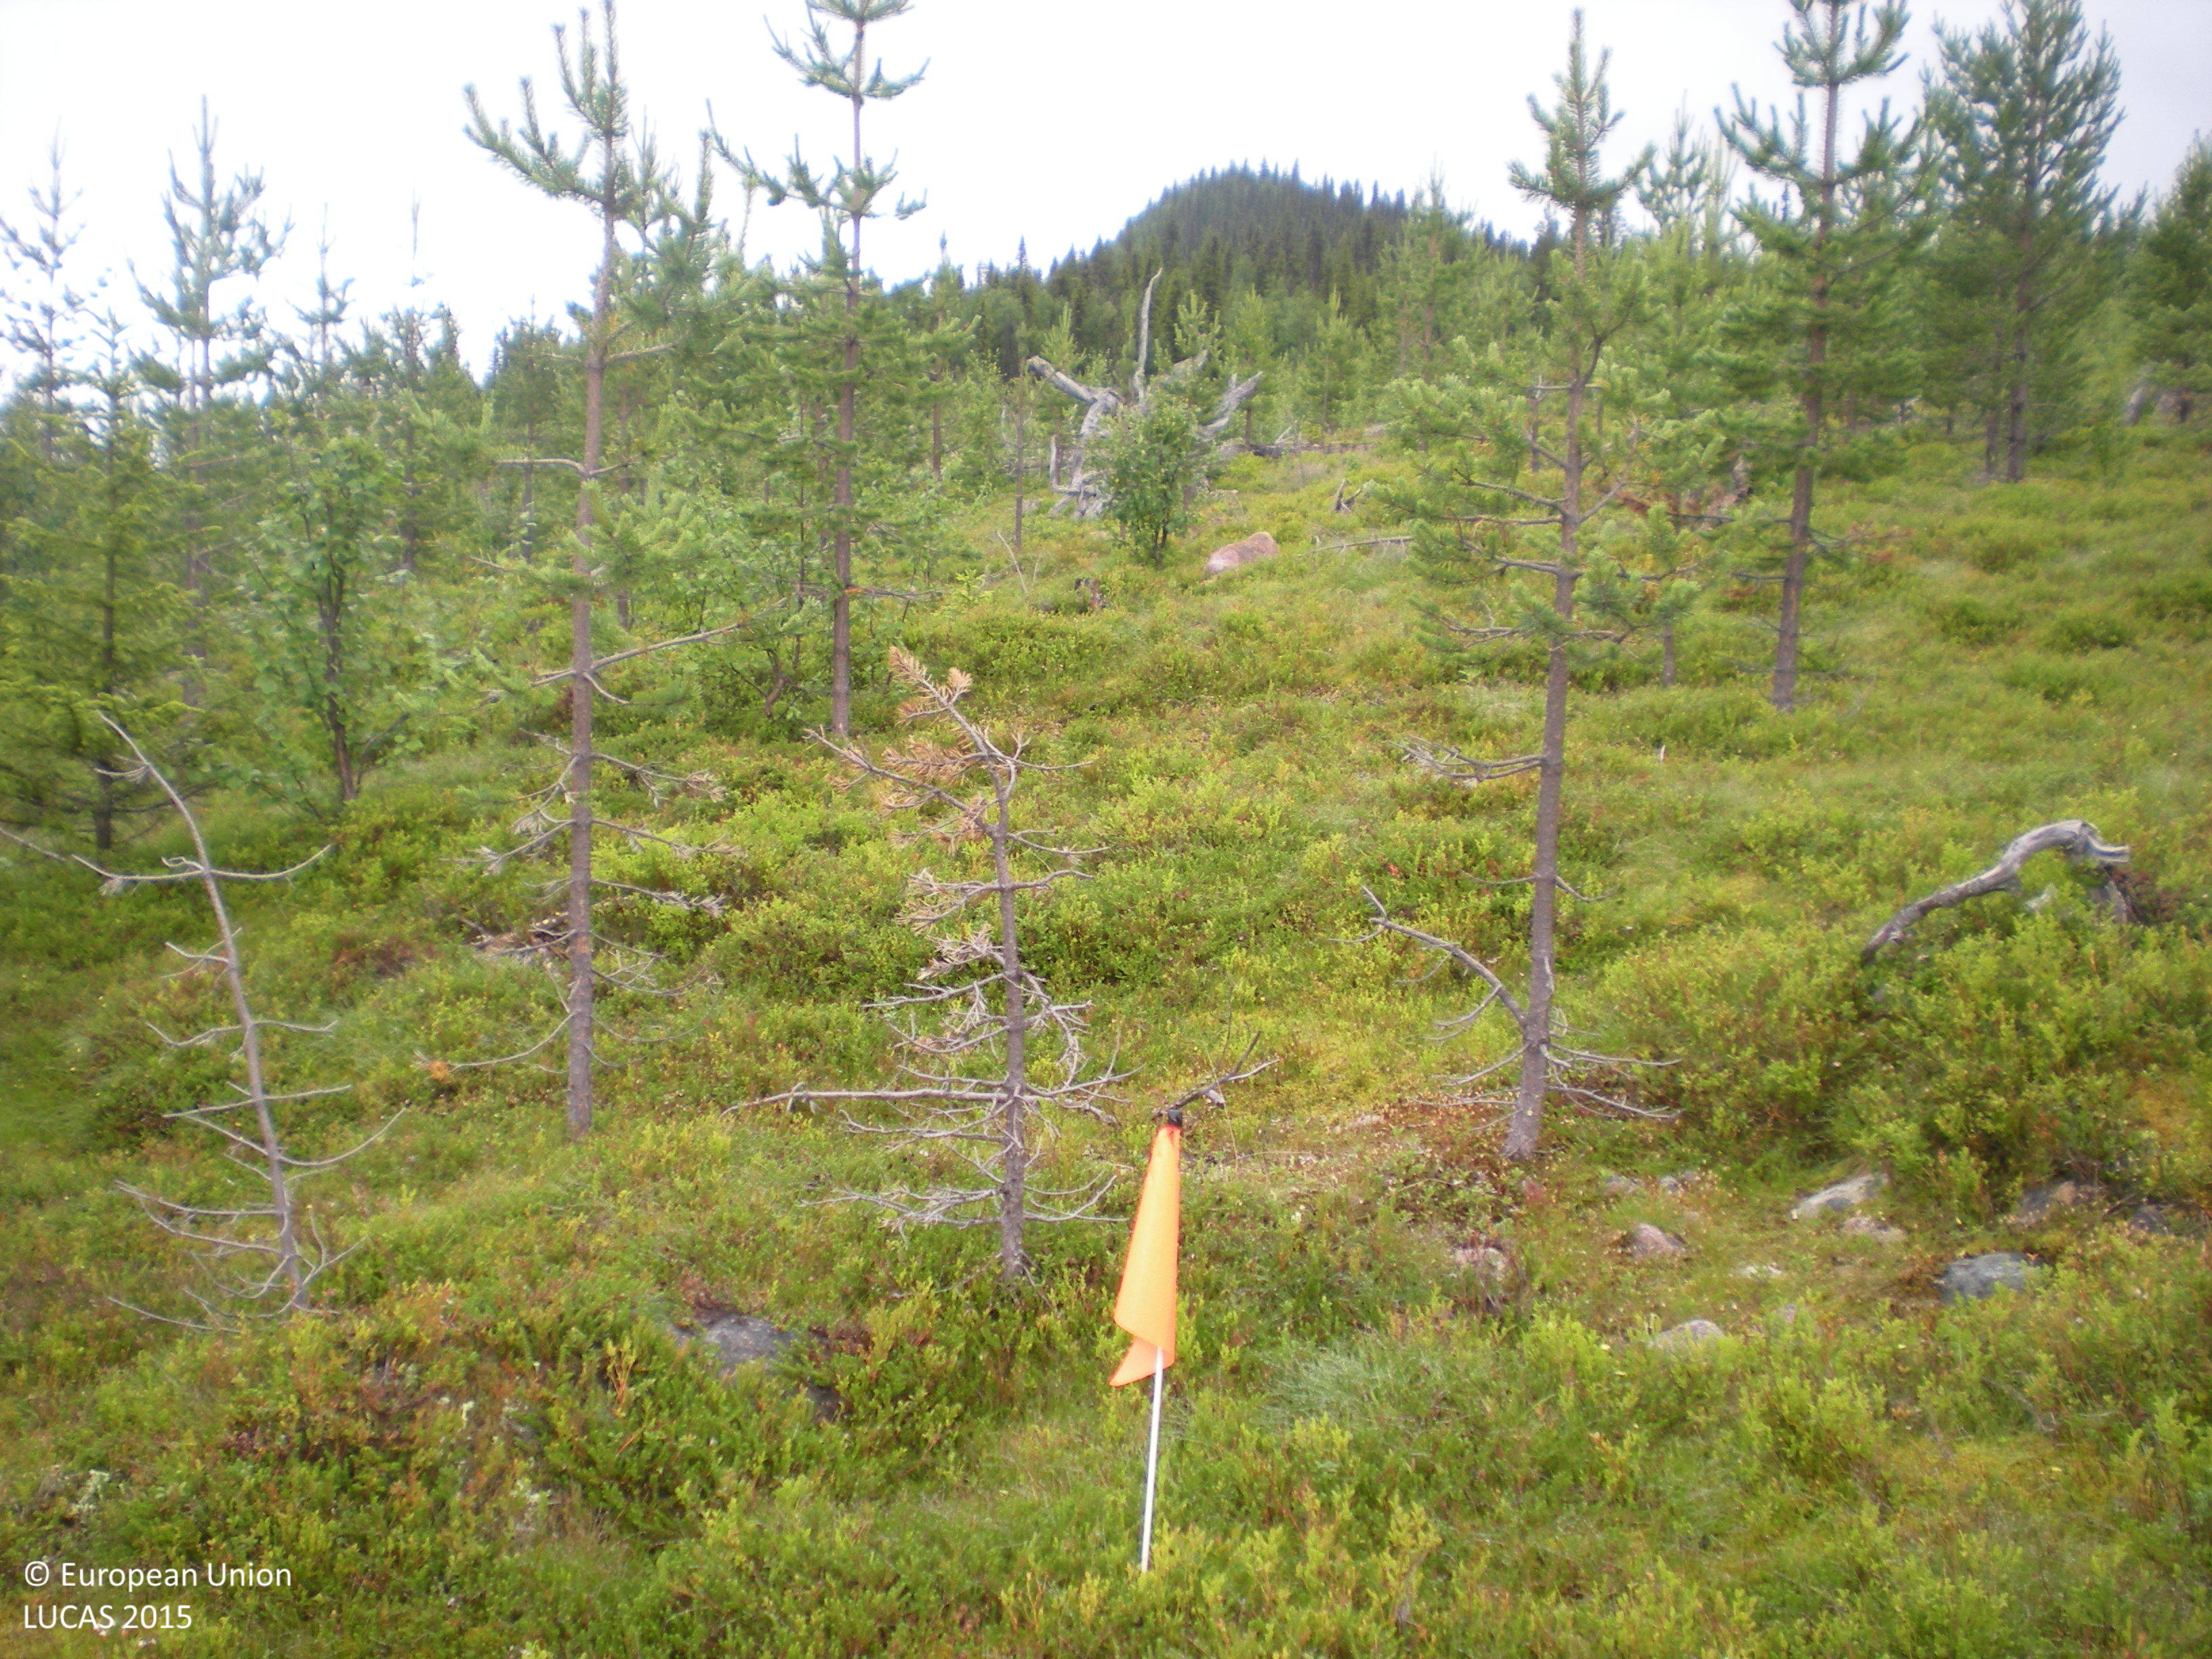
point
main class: Woodland
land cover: Pine dominated mixed woodland
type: boreal forest
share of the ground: 25 - 50 %
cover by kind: coniferous forest trees 35 %, shrubs 30 %, broadleaved forest trees 15 %, lichens and mosses 15 %, herbaceous plants 5 %
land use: Forestry
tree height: < 5 m
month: August
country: SE
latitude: 66.0867
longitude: 18.3781
